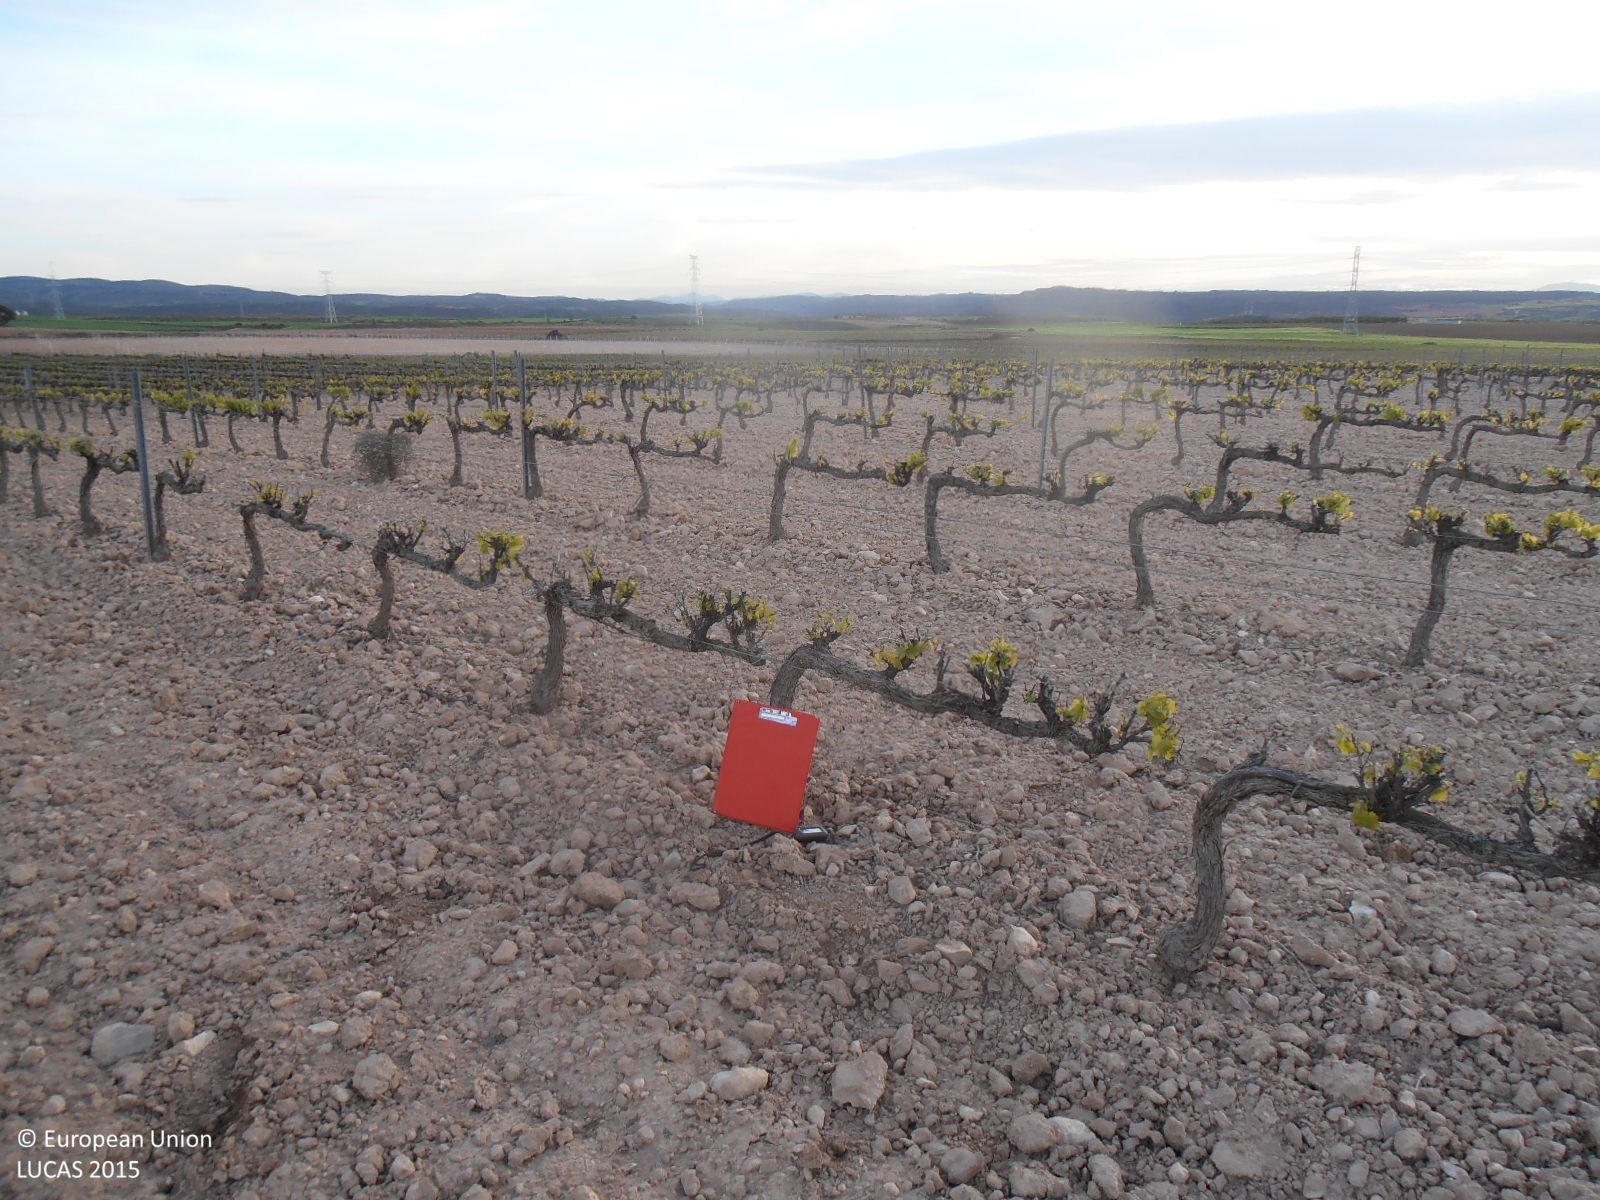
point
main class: Cropland
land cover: Vineyards
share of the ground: 10 - 25 %
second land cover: Other bare soil
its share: > 75 %
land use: Agriculture (excluding fallow land and kitchen gardens)
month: April
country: ES
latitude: 41.3602
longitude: -1.0056
